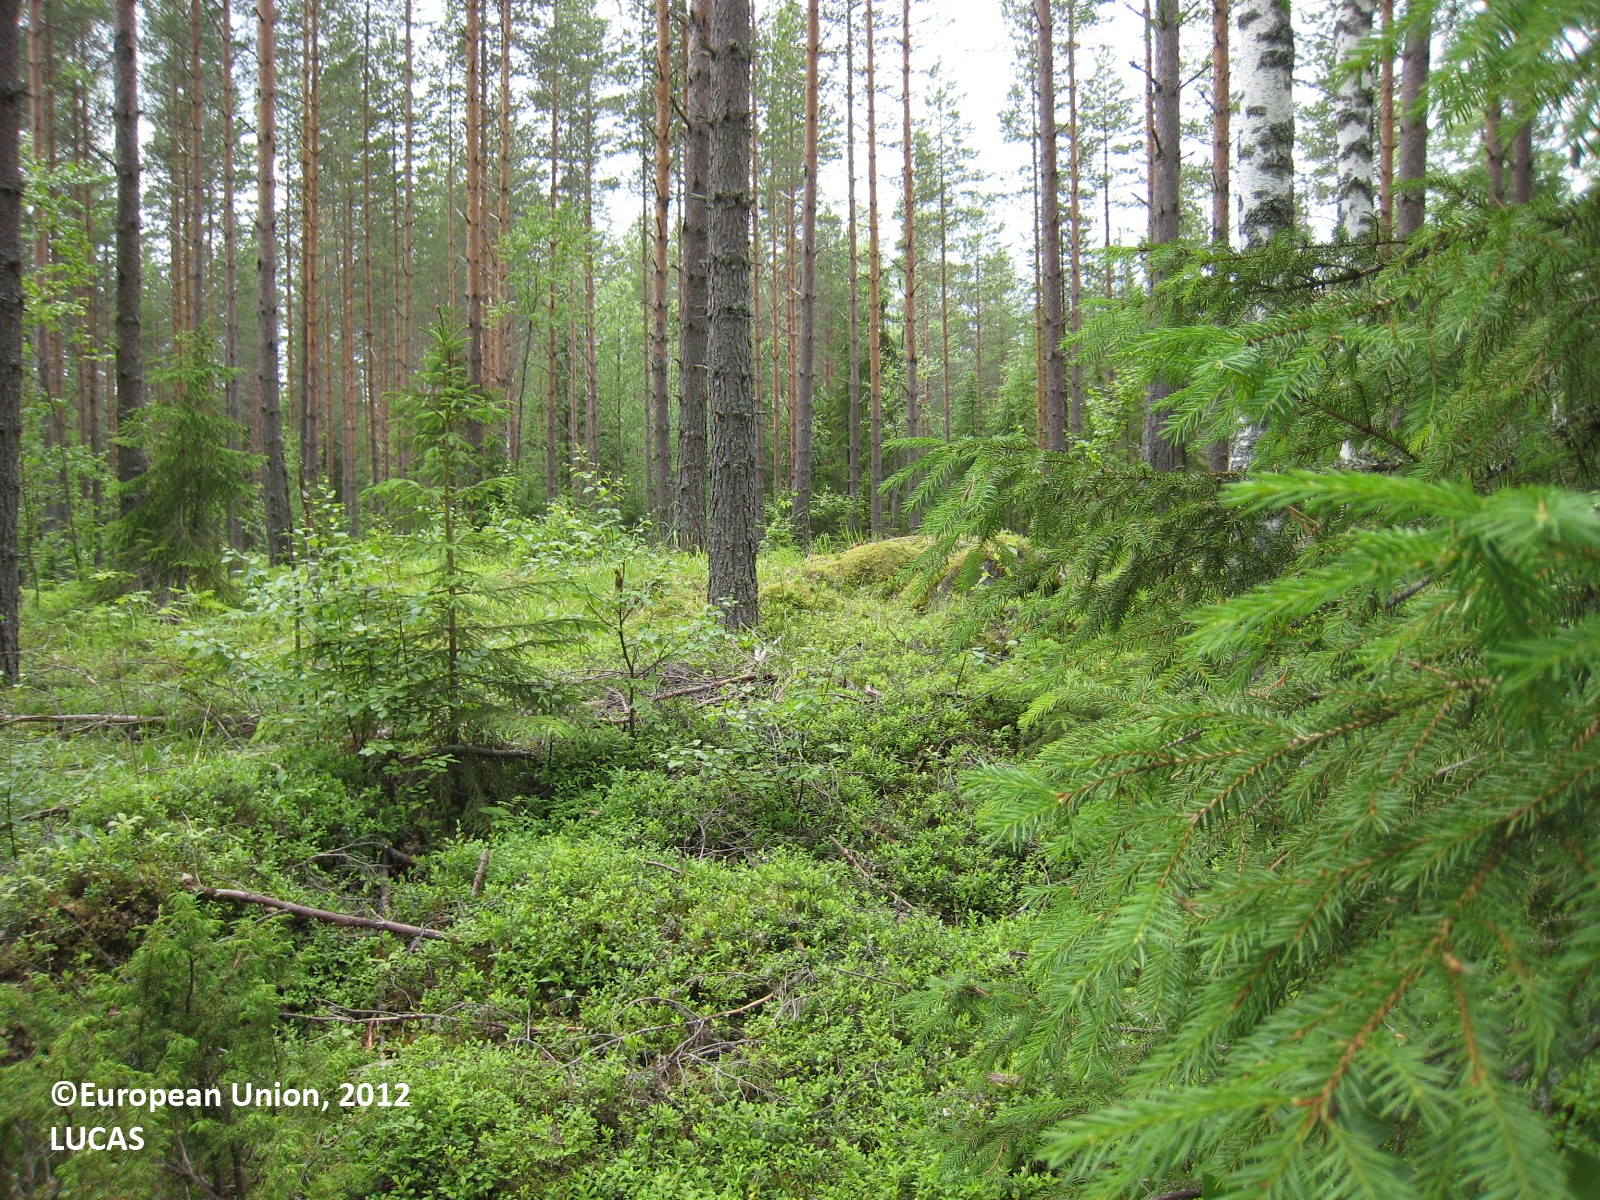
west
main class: Woodland
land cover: Pine dominated coniferous woodland
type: boreal forest
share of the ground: 25 - 50 %
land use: Forestry
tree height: > 5 m
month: June
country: FI
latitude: 62.0130
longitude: 26.2775
